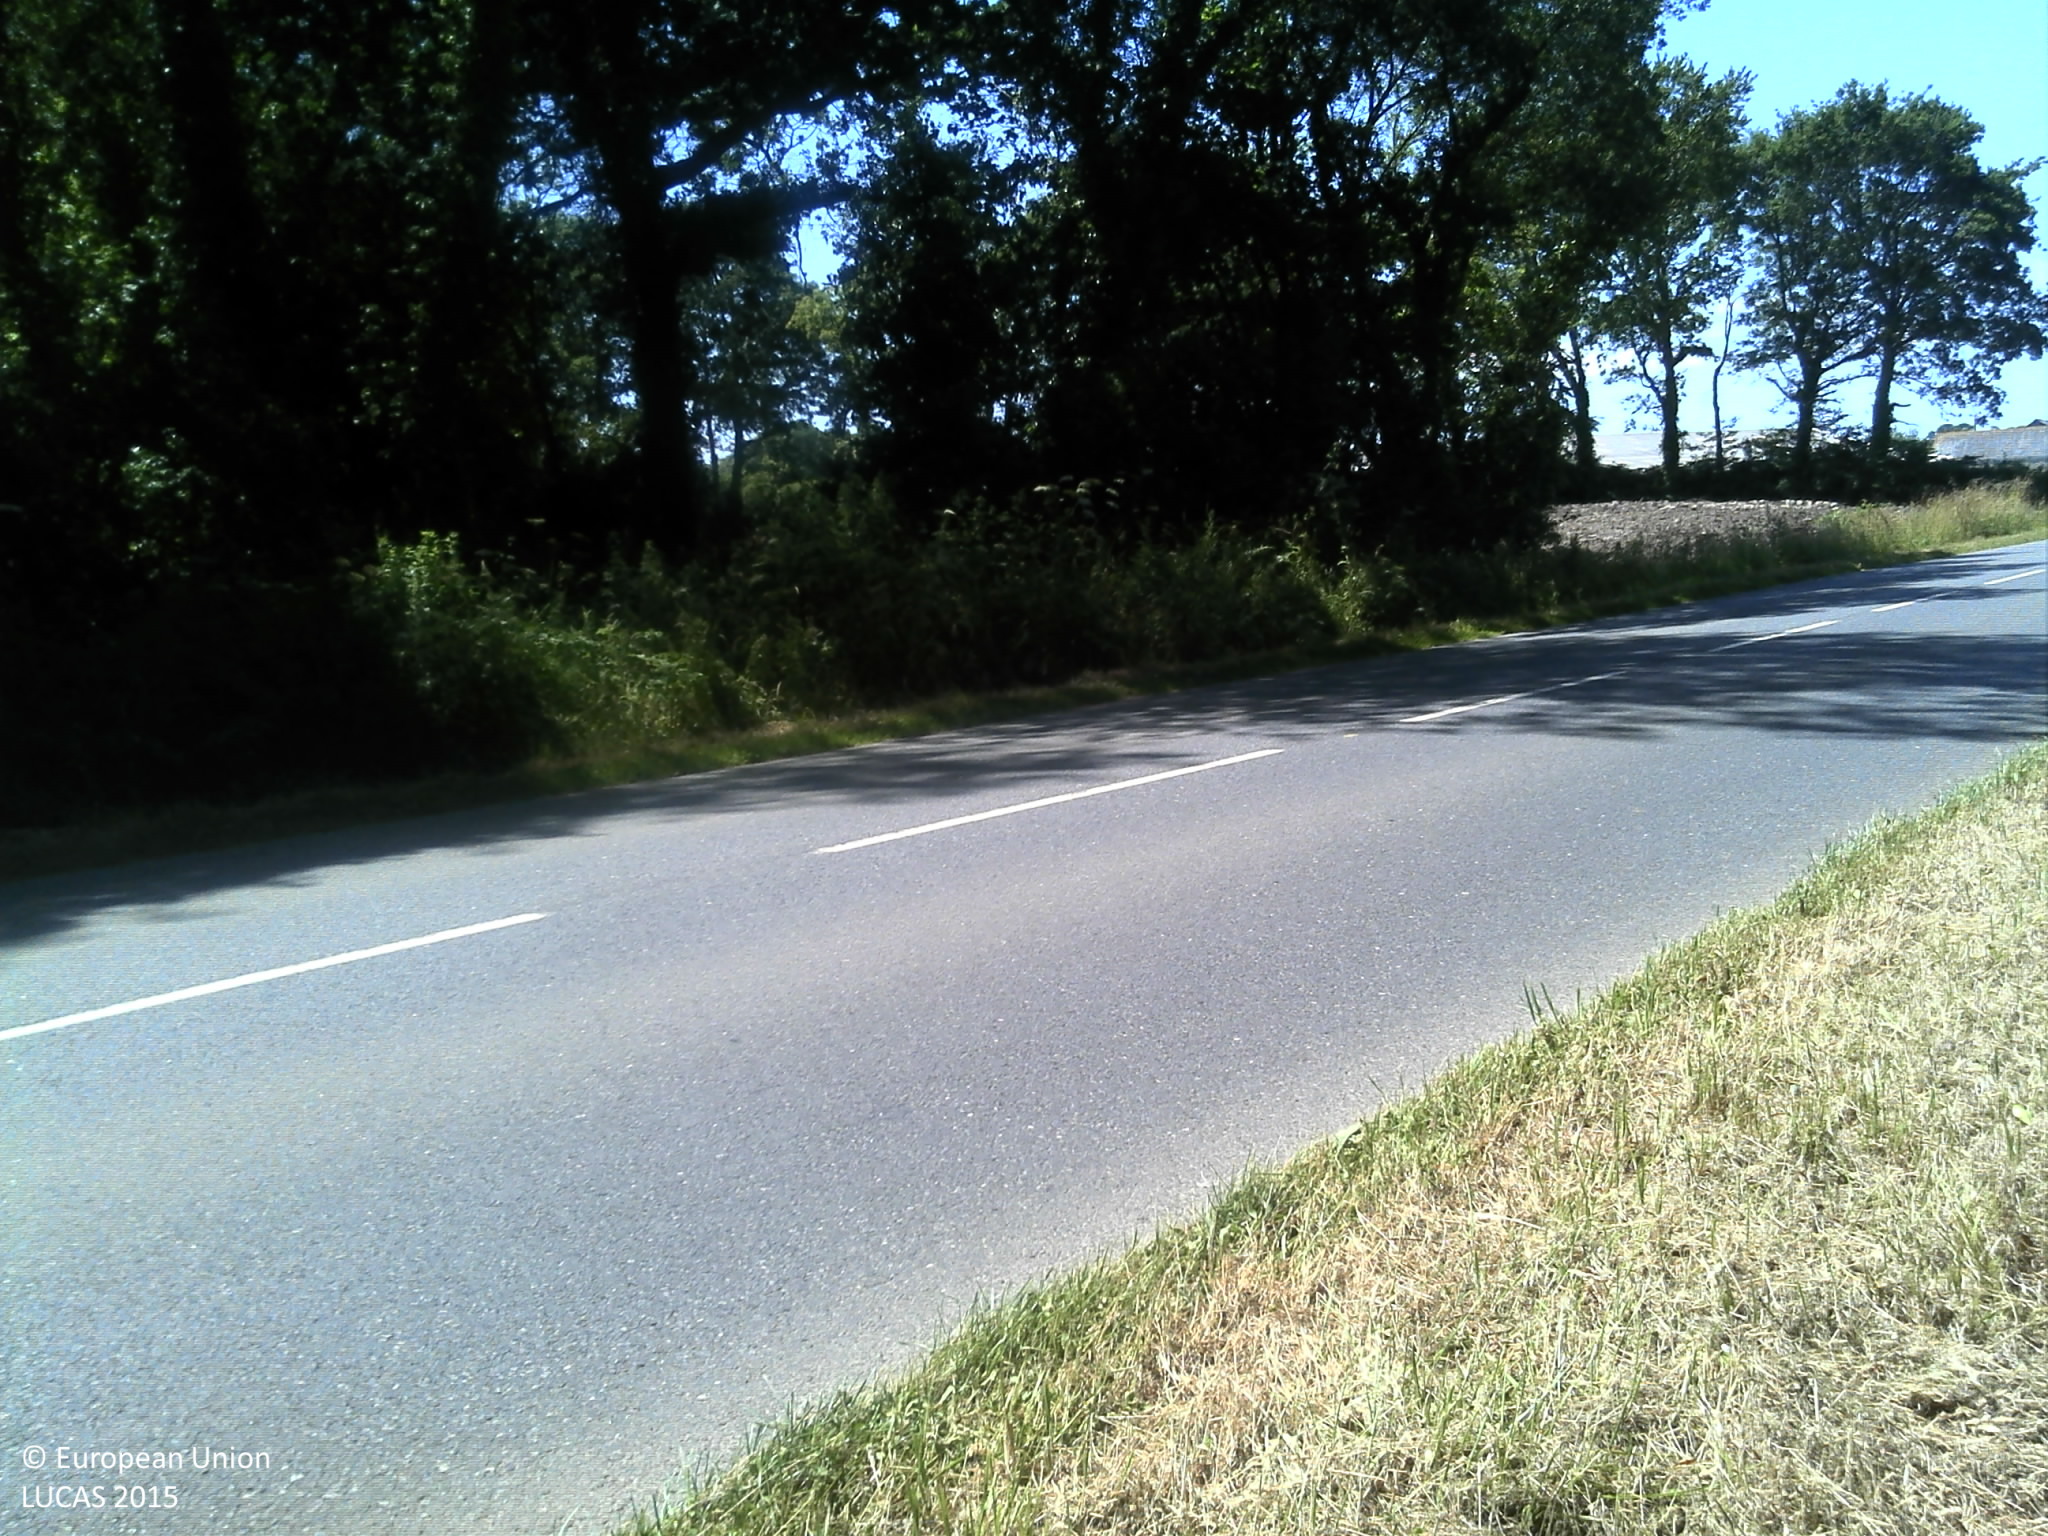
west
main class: Woodland
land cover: Broadleaved woodland
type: mesophytic deciduous forest
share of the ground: > 75 %
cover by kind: broadleaved forest trees 100 %
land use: Forestry
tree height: > 5 m
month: July
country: FR
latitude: 48.6698
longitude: -3.7587
